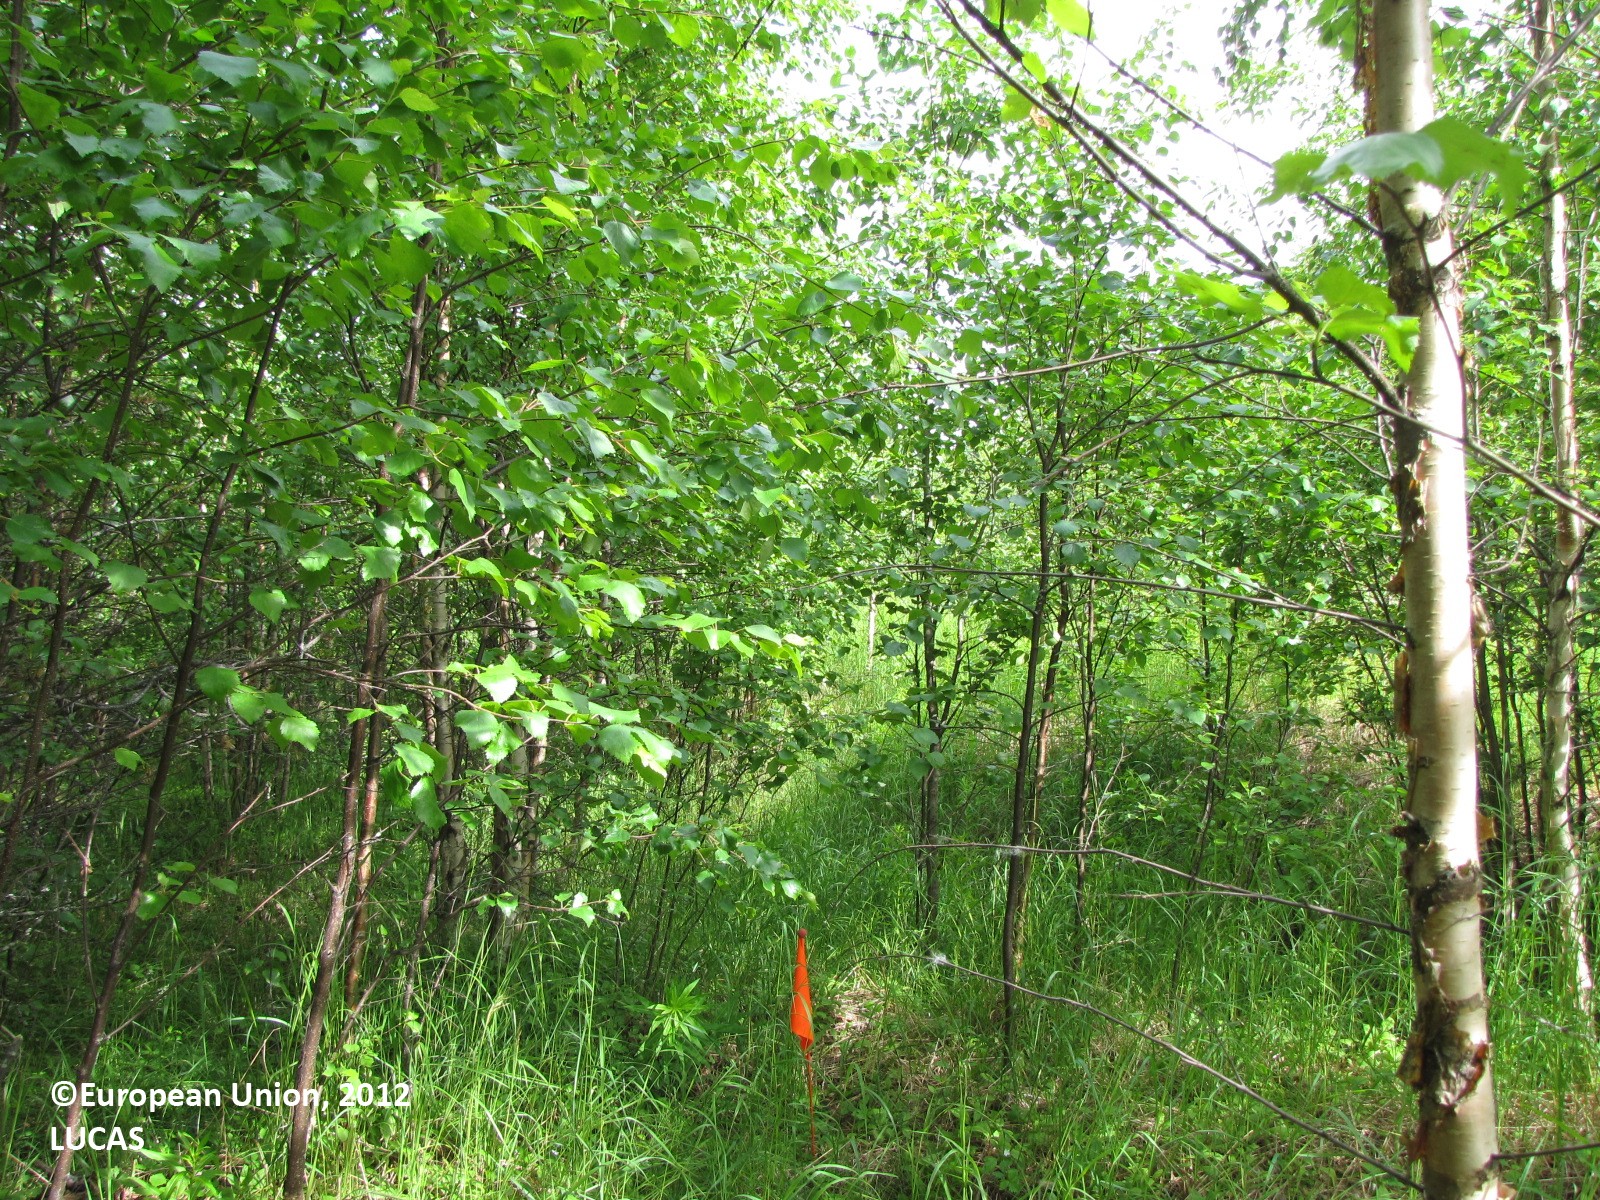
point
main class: Woodland
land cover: Broadleaved woodland
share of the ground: 50 - 75 %
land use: Forestry
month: July
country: FI
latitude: 66.1420
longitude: 25.1502
